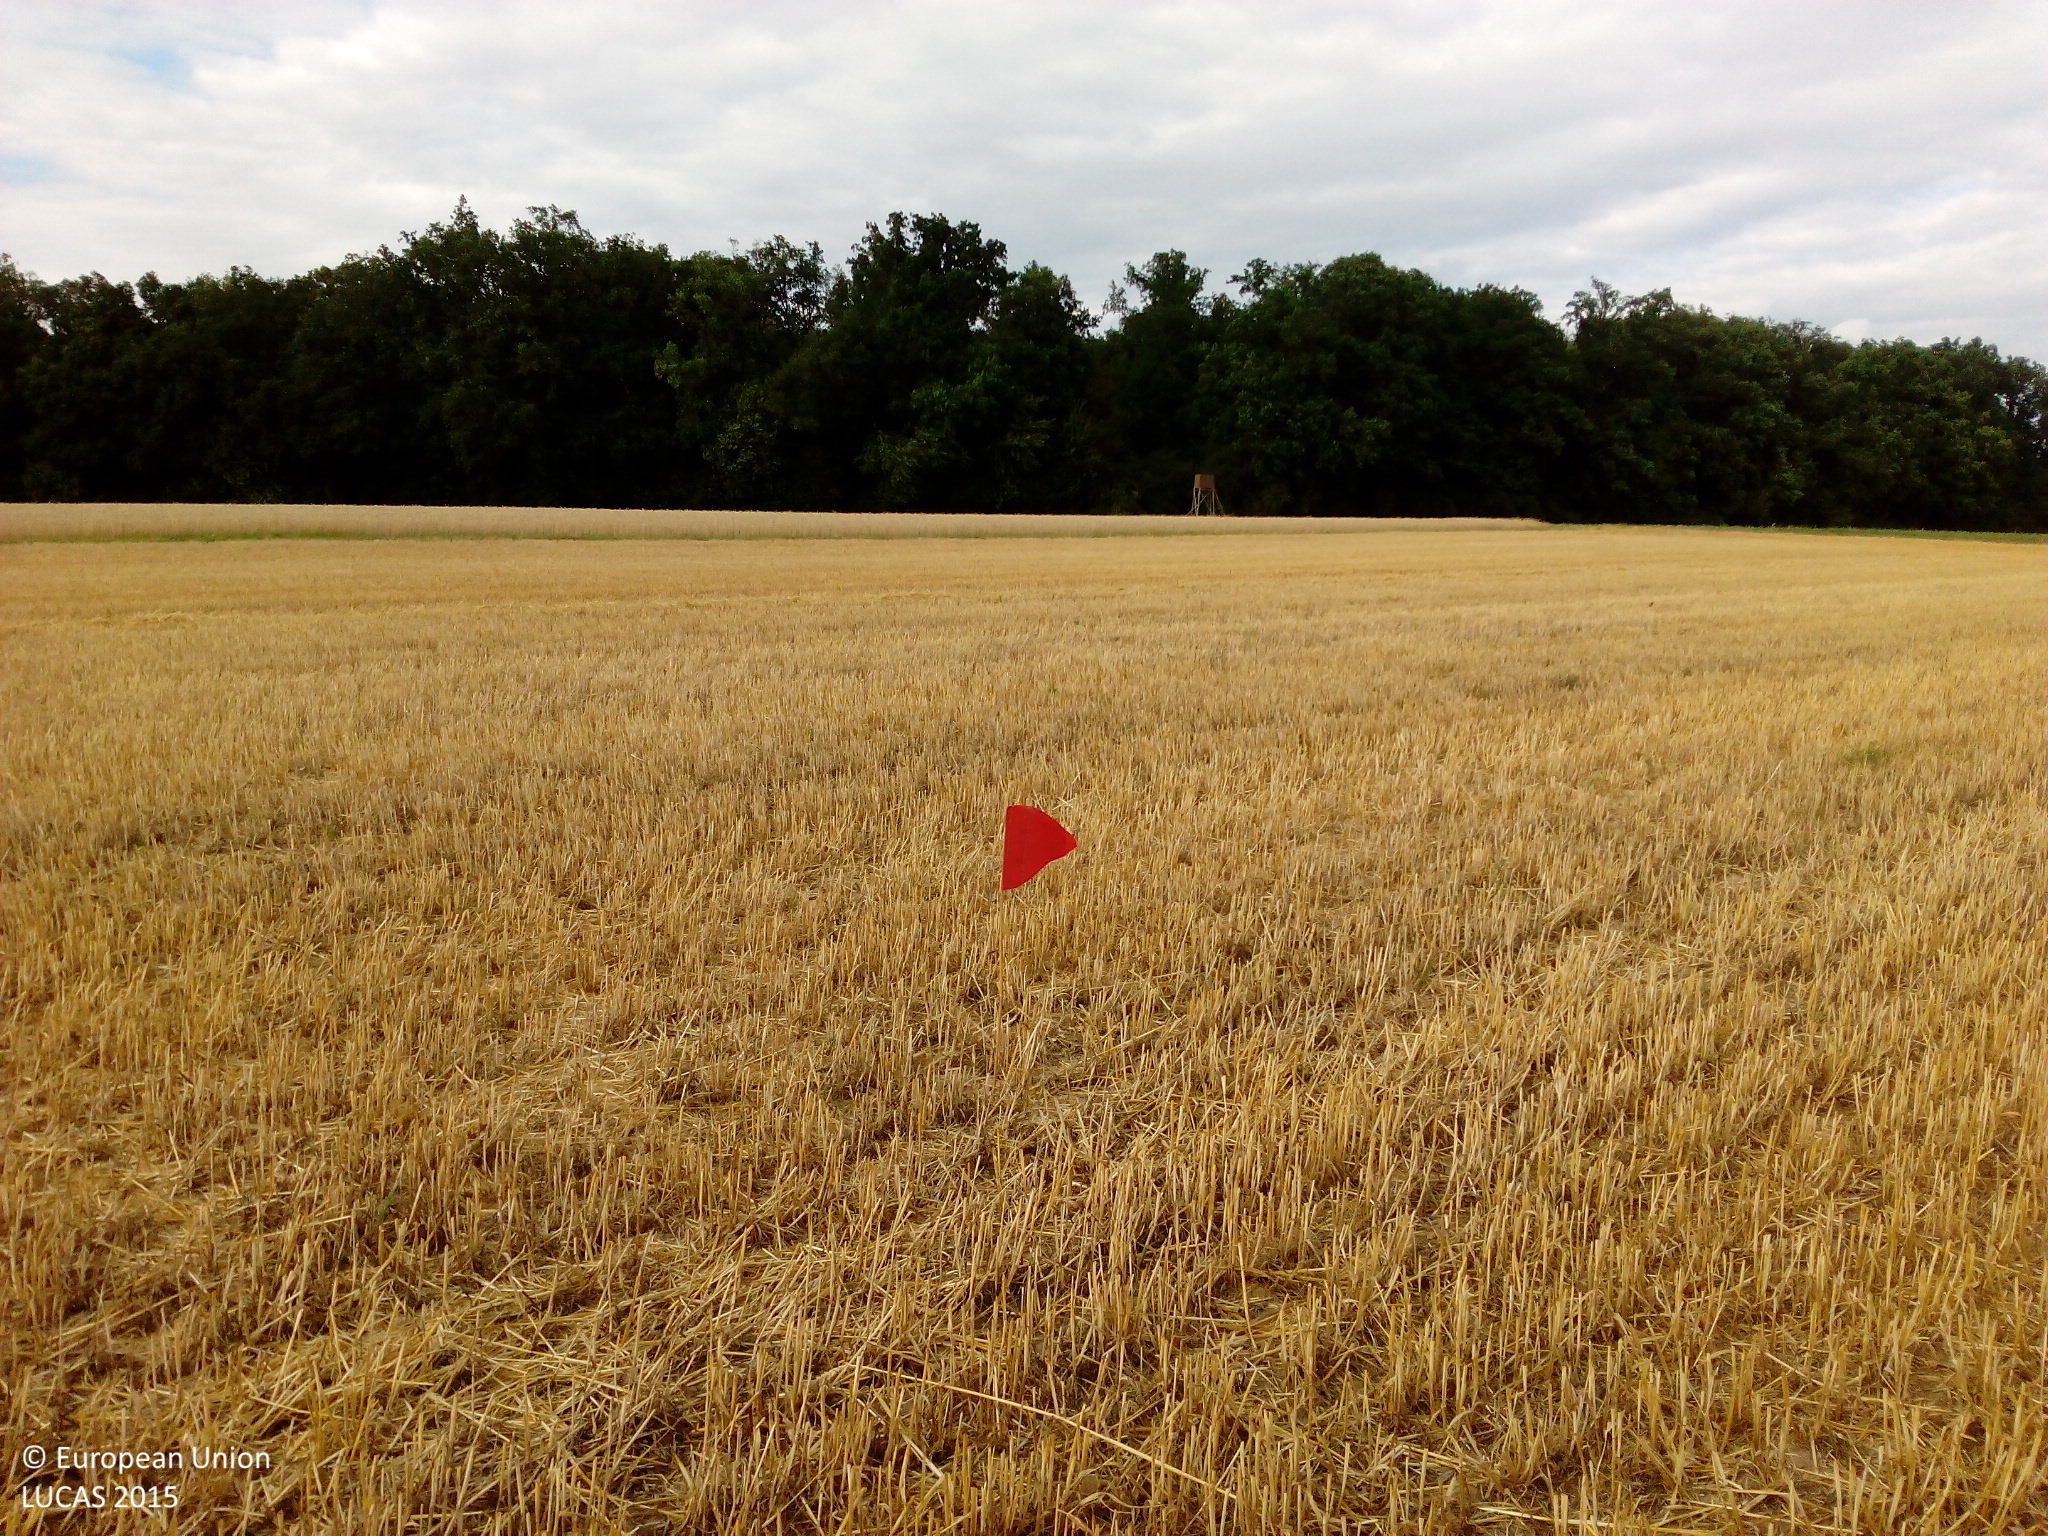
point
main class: Cropland
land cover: Barley
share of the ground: 50 - 75 %
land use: Agriculture (excluding fallow land and kitchen gardens)
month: July
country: DE
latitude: 49.7346
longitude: 9.9307
